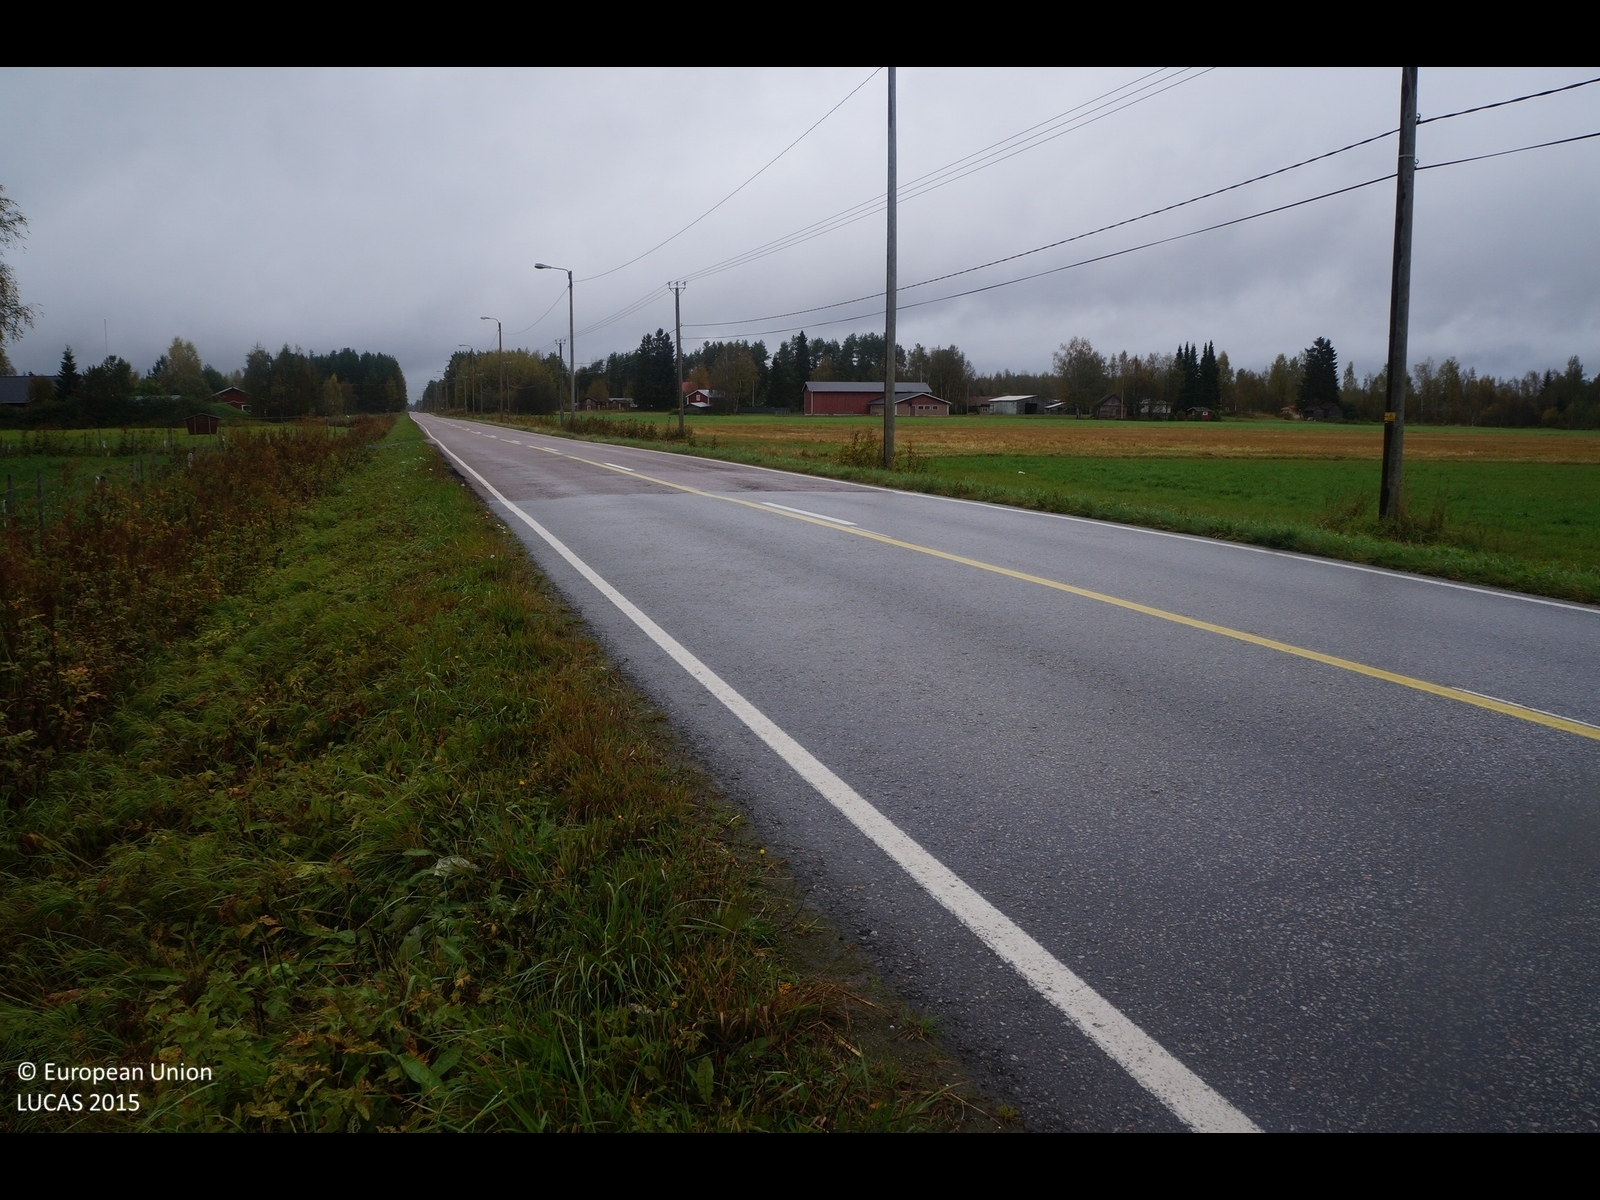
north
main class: Woodland
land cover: Broadleaved woodland
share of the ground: > 75 %
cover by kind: broadleaved forest trees 75 %, herbaceous plants 15 %, shrubs 10 %
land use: Forestry
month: September
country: FI
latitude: 64.1323
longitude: 24.3058
